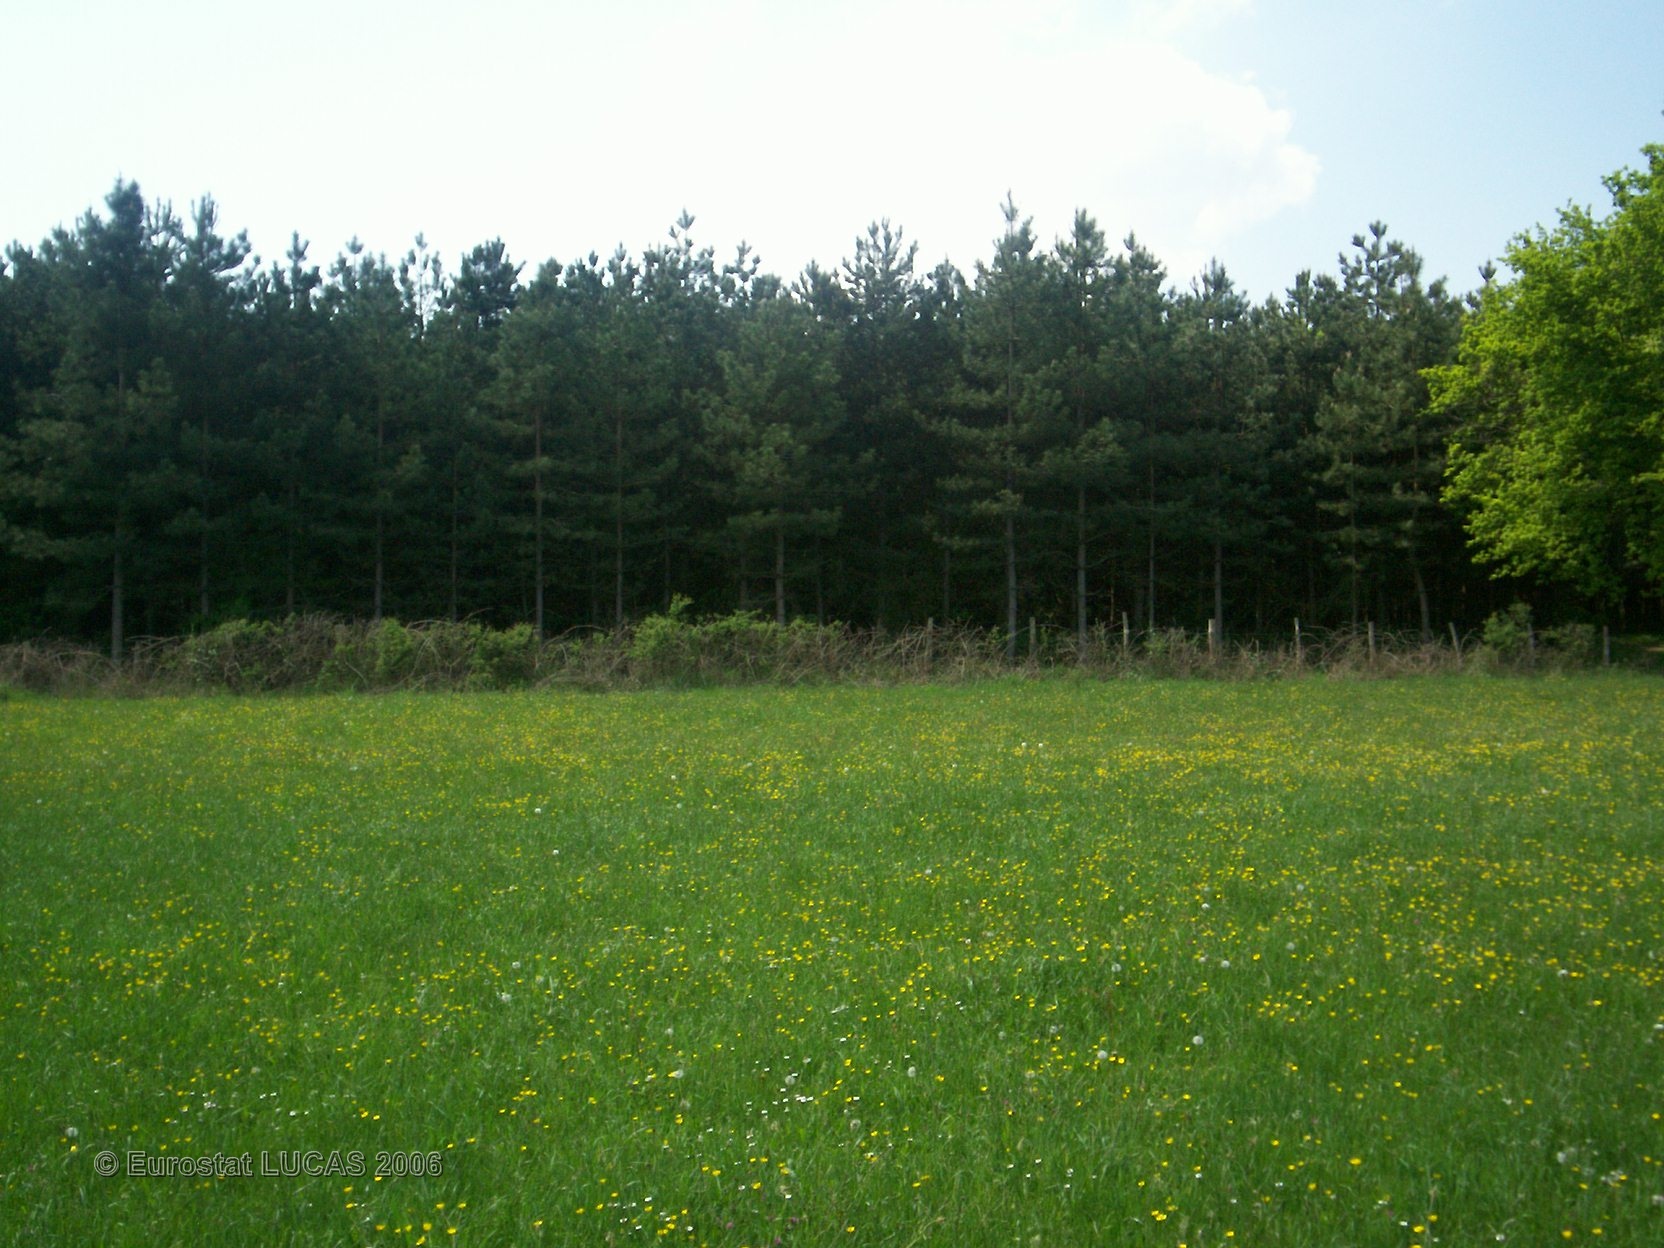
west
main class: Grassland
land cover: Grassland without tree/shrub cover
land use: Agriculture (excluding fallow land and kitchen gardens)
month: May
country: FR
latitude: 47.7114
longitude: 0.1783
